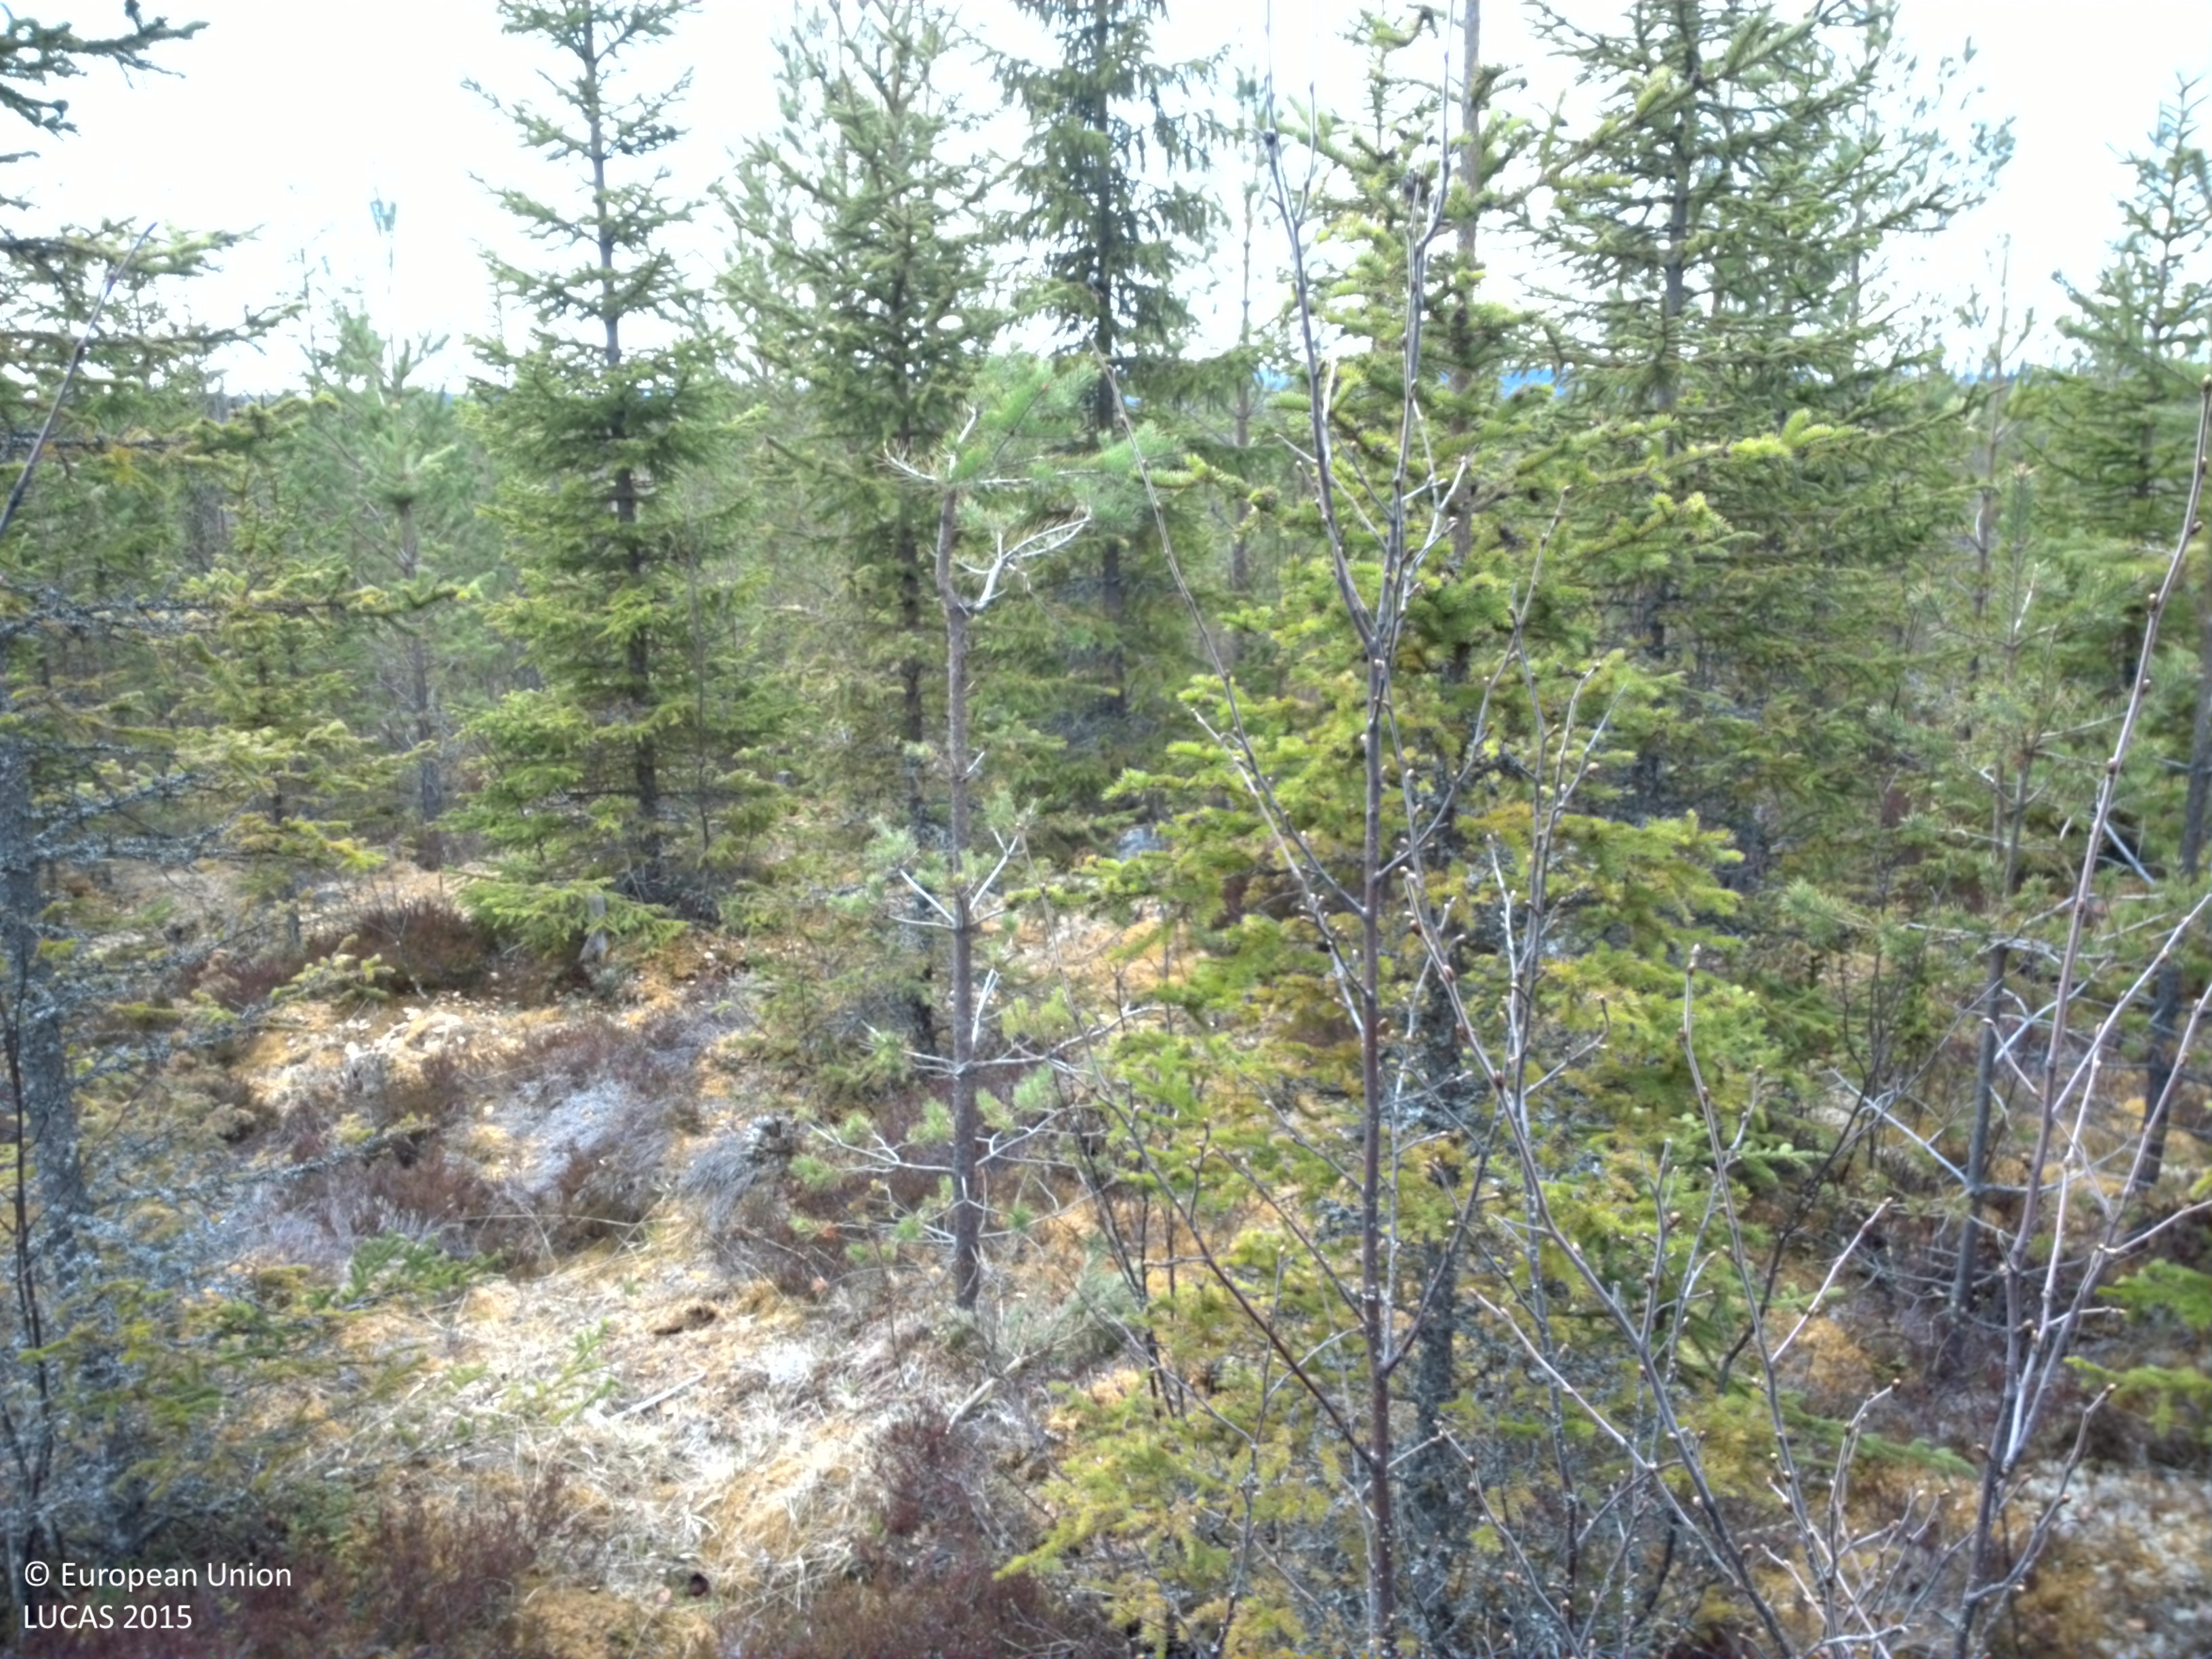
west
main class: Woodland
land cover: Spruce dominated coniferous woodland
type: boreal forest
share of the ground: > 75 %
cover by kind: coniferous forest trees 80 %, shrubs 20 %
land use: Forestry
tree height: > 5 m
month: May
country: SE
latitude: 62.6190
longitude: 14.4446
